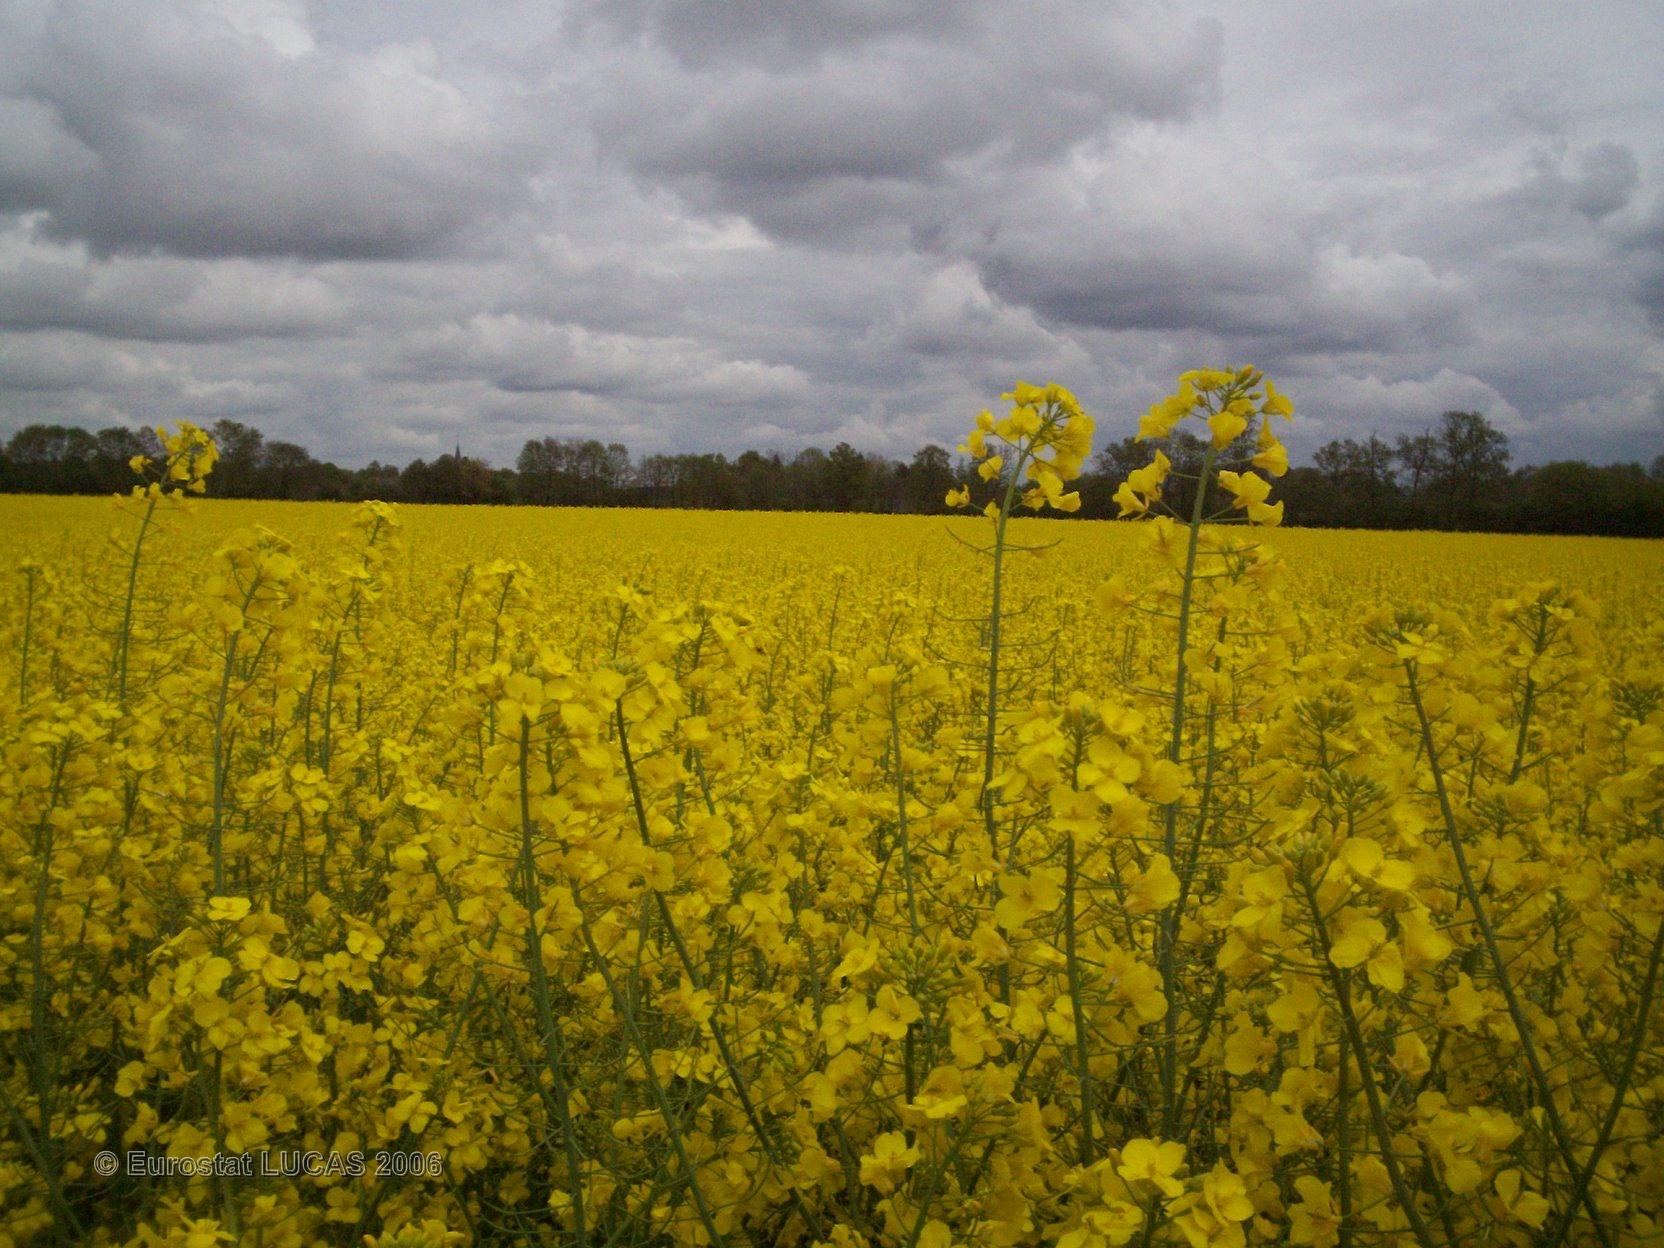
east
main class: Cropland
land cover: Rape and turnip rape
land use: Agriculture (excluding fallow land and kitchen gardens)
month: May
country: FR
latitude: 49.1529
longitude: 0.4995
